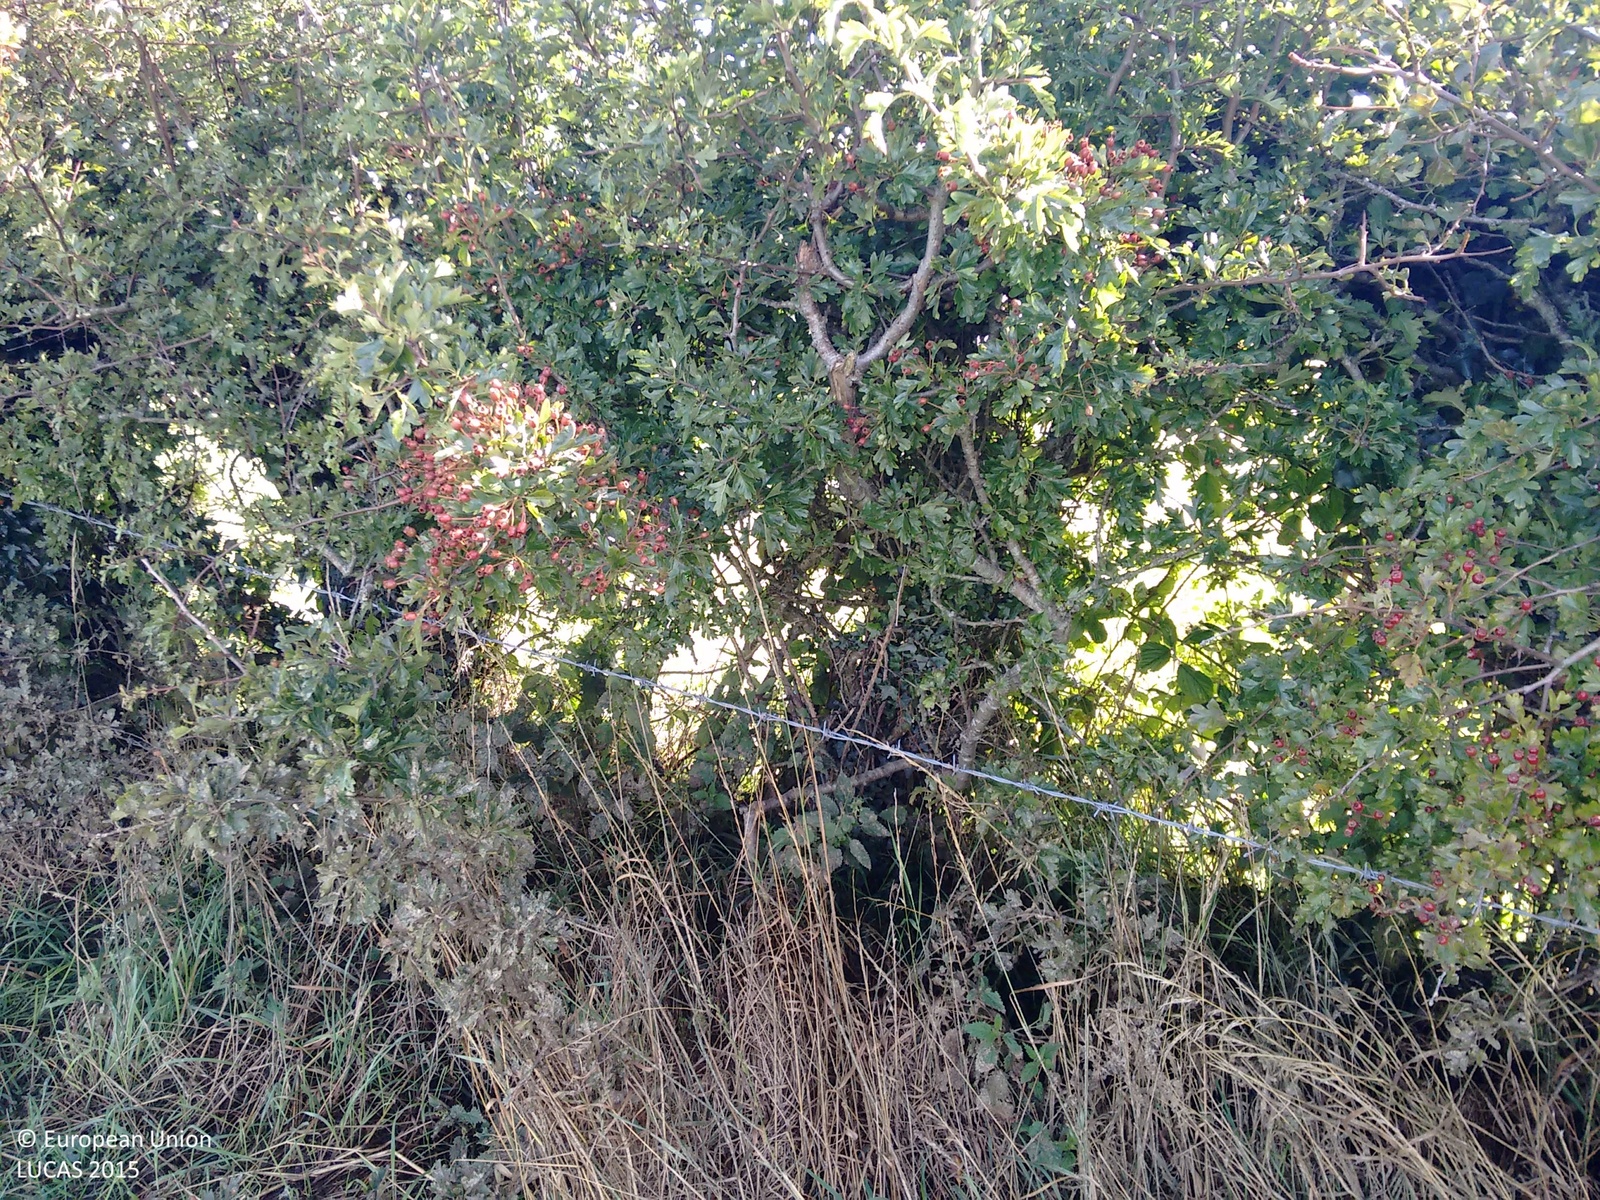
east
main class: Grassland
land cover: Grassland without tree/shrub cover
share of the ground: > 75 %
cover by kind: herbaceous plants 100 %
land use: Agriculture (excluding fallow land and kitchen gardens)
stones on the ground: < 10 %
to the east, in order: Grassland without tree/shrub cover; Fences; Abandoned hedges; Fences; Grassland without tree/shrub cover; Fences; Abandoned hedges; Grassland without tree/shrub cover
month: August
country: GB
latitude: 54.4017
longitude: -5.8652
